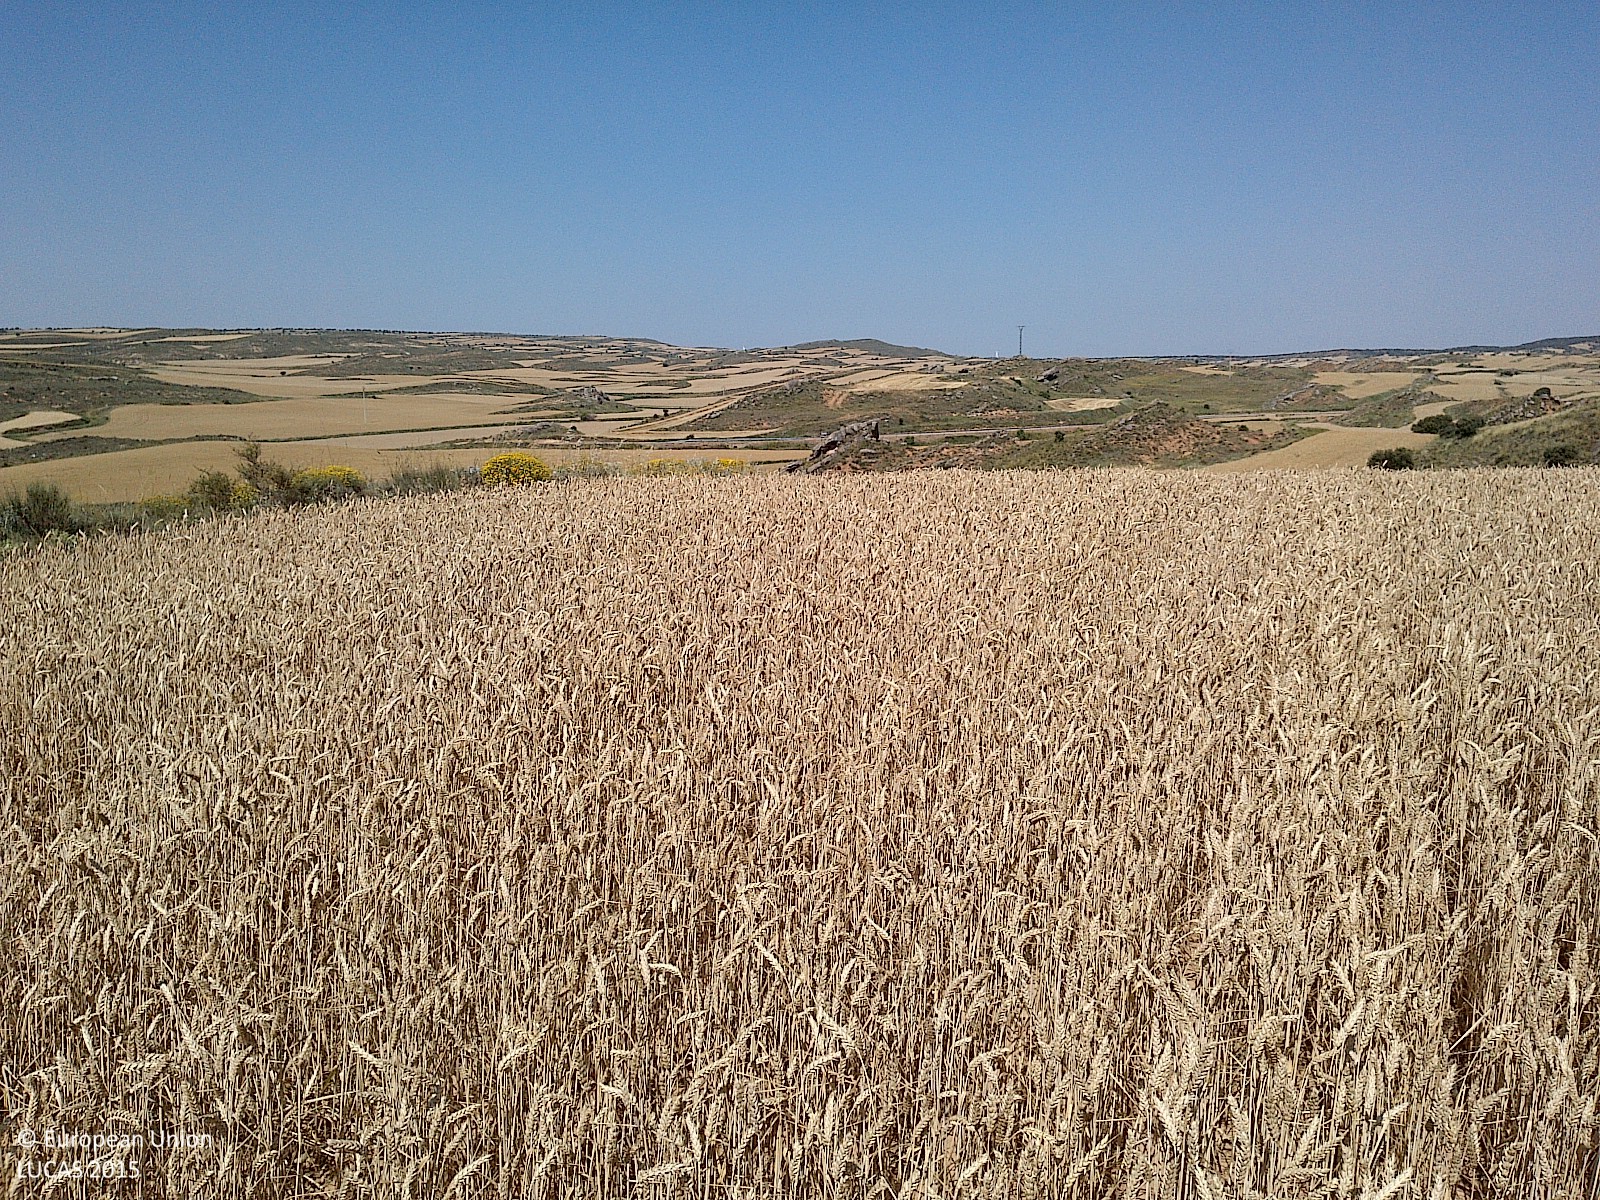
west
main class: Cropland
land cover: Common wheat
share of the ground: > 75 %
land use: Agriculture (excluding fallow land and kitchen gardens)
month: July
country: ES
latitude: 41.5572
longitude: -2.1301
